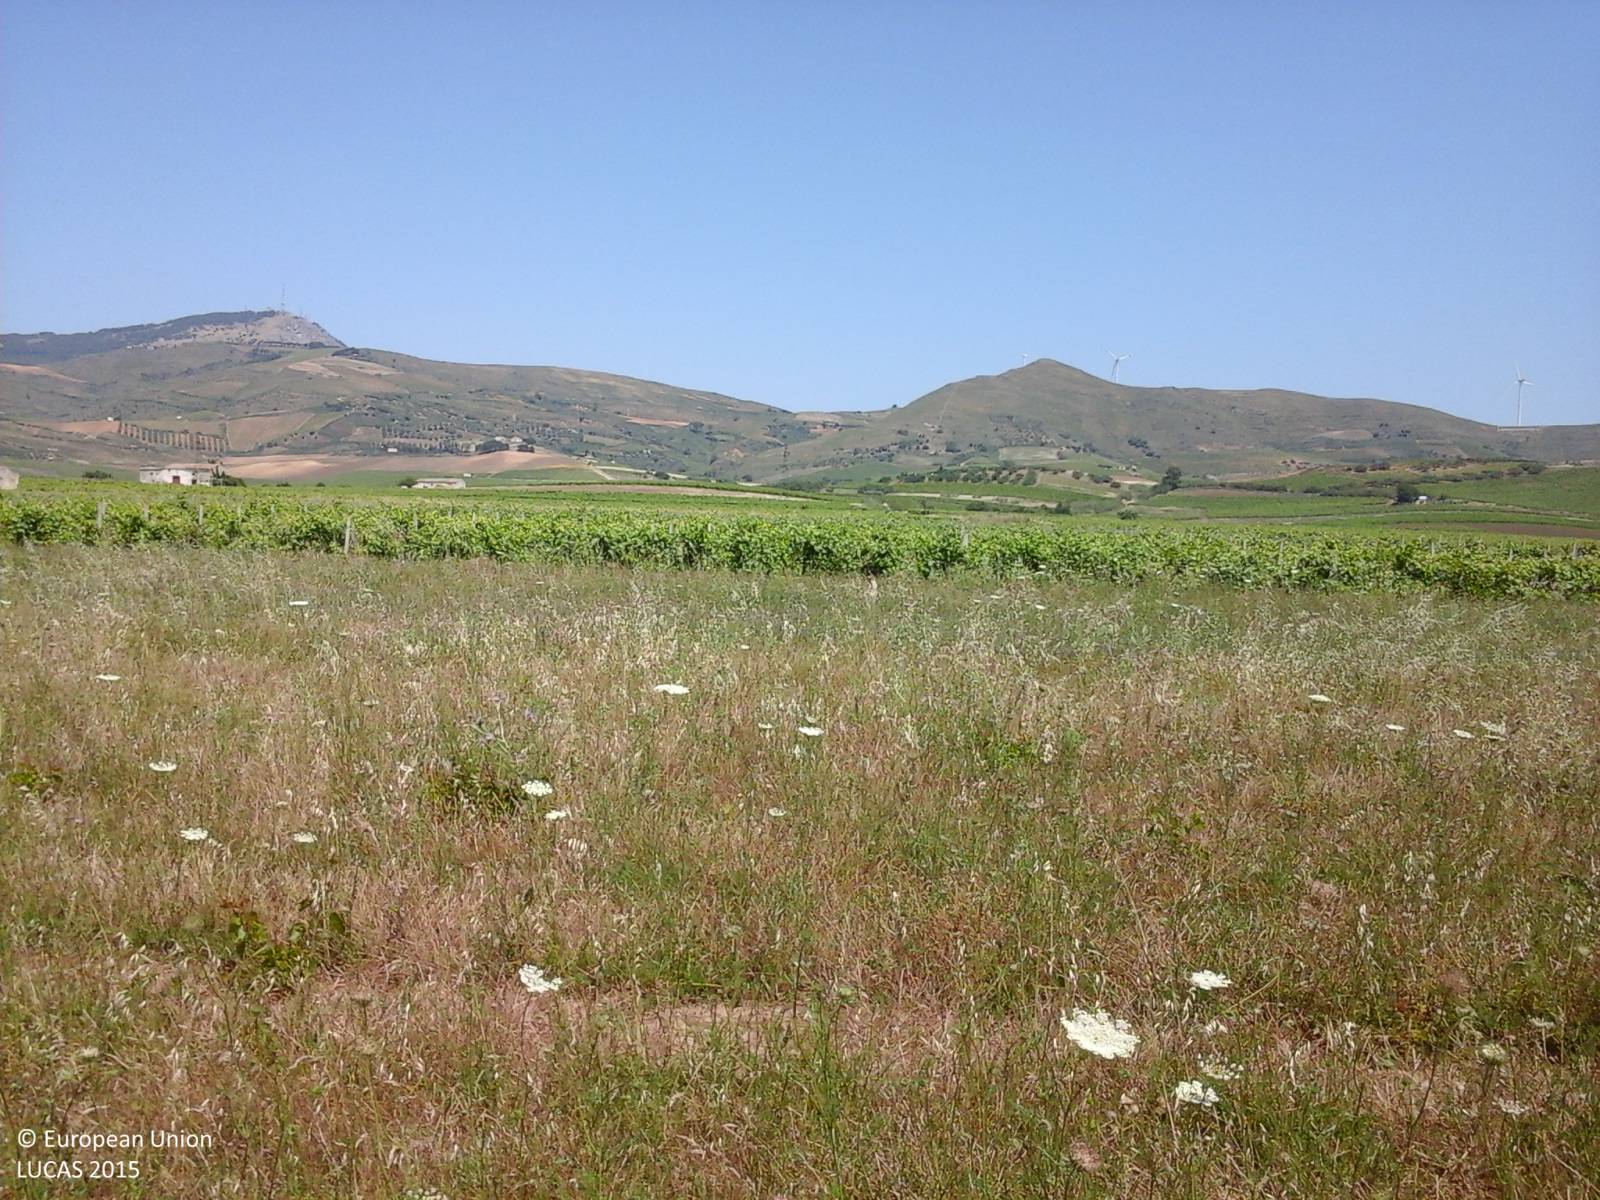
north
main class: Grassland
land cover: Grassland without tree/shrub cover
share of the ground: > 75 %
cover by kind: herbaceous plants 100 %
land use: Abandoned areas
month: June
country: IT
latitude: 37.9184
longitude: 12.9927
